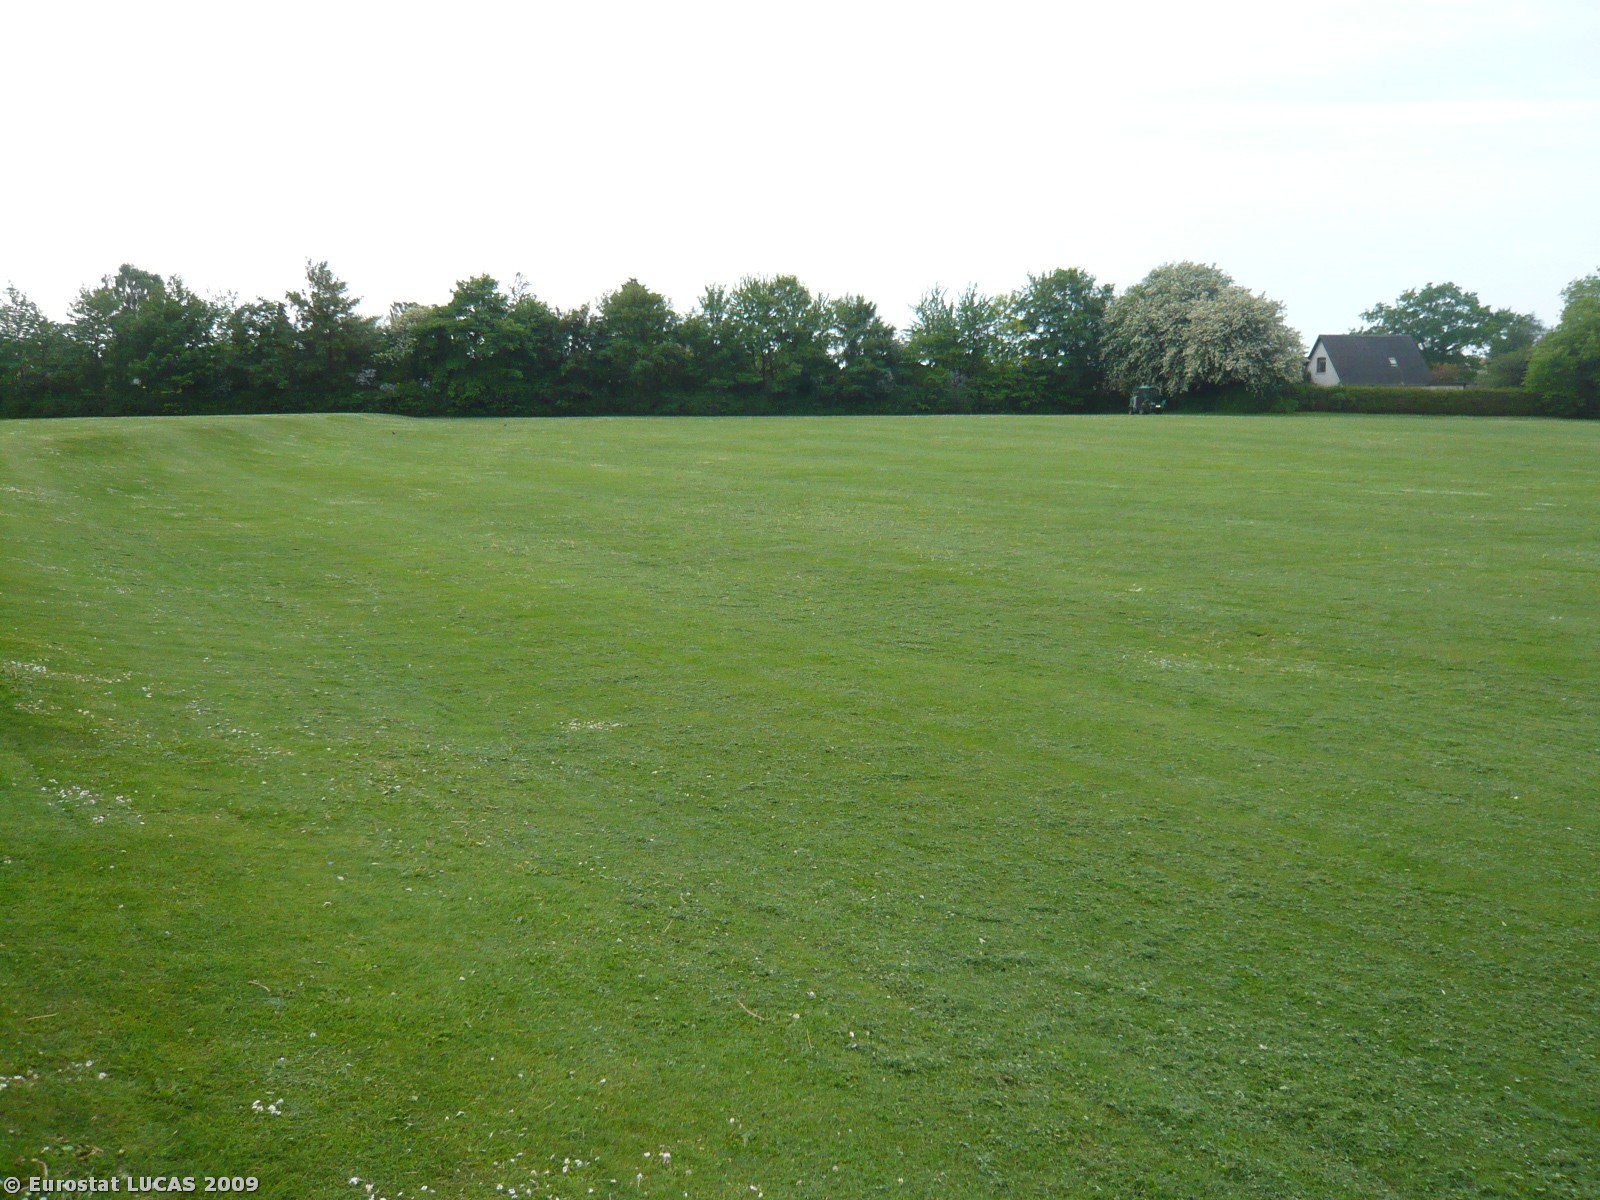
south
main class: Grassland
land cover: Grassland without tree/shrub cover
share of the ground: > 75 %
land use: Sport
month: May
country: DK
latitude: 55.2406
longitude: 11.7758
